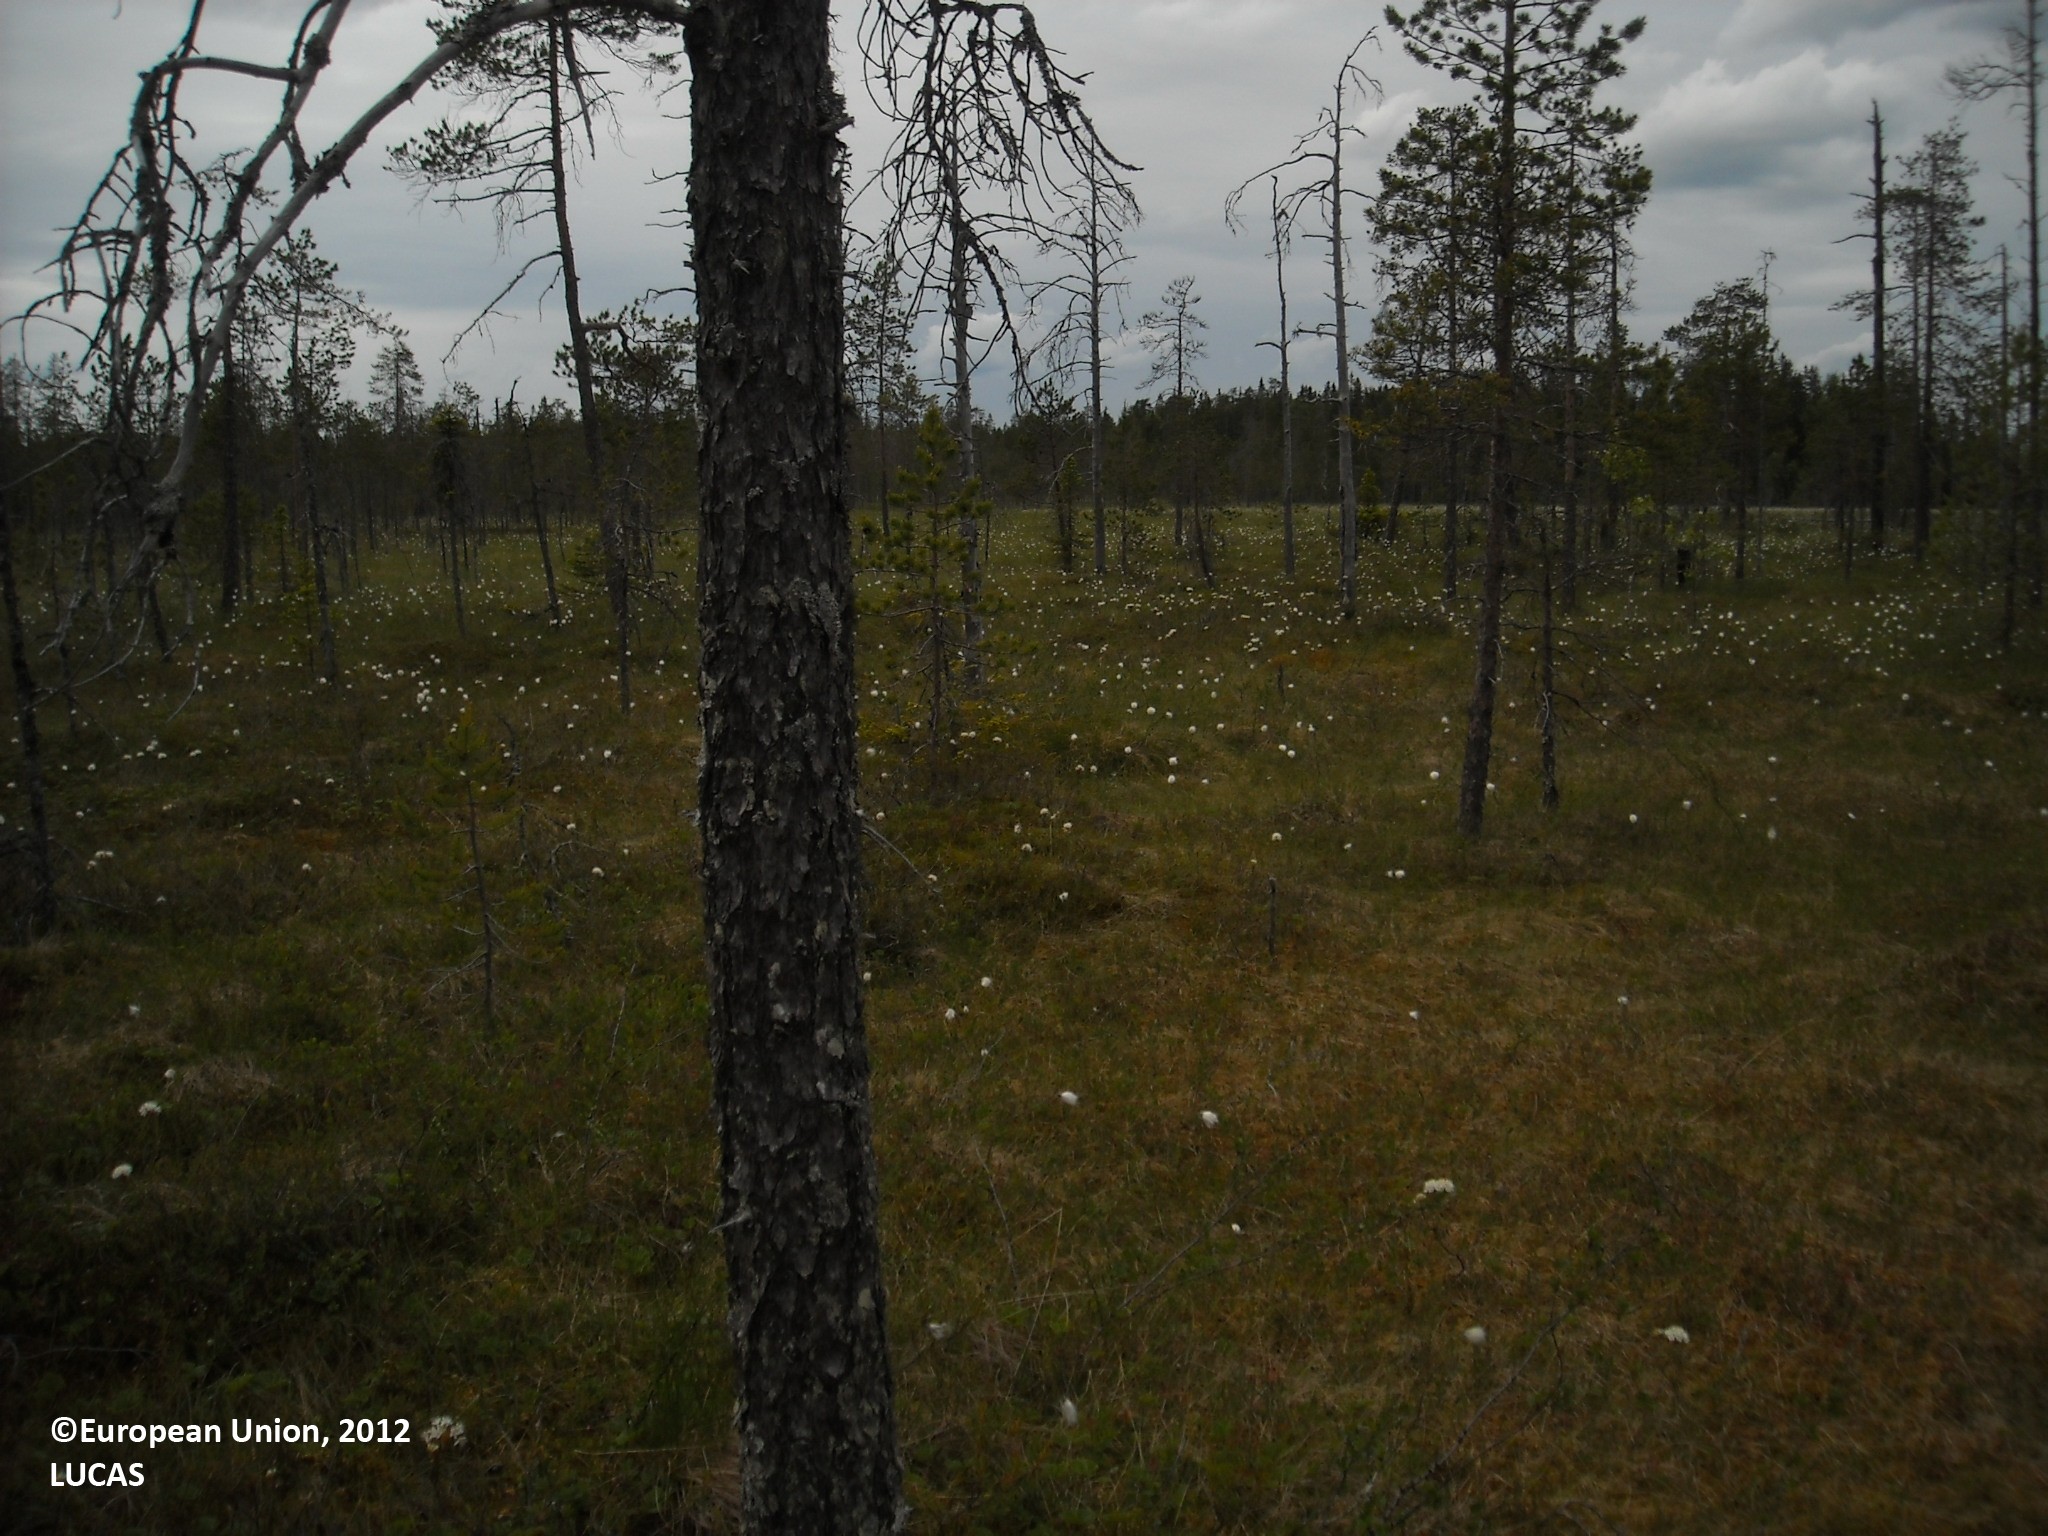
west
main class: Woodland
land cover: Pine dominated coniferous woodland
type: mire and swamp forests
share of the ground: 10 - 25 %
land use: Semi-natural and natural areas not in use
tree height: > 5 m
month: June
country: FI
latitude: 64.8843
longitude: 27.9961
